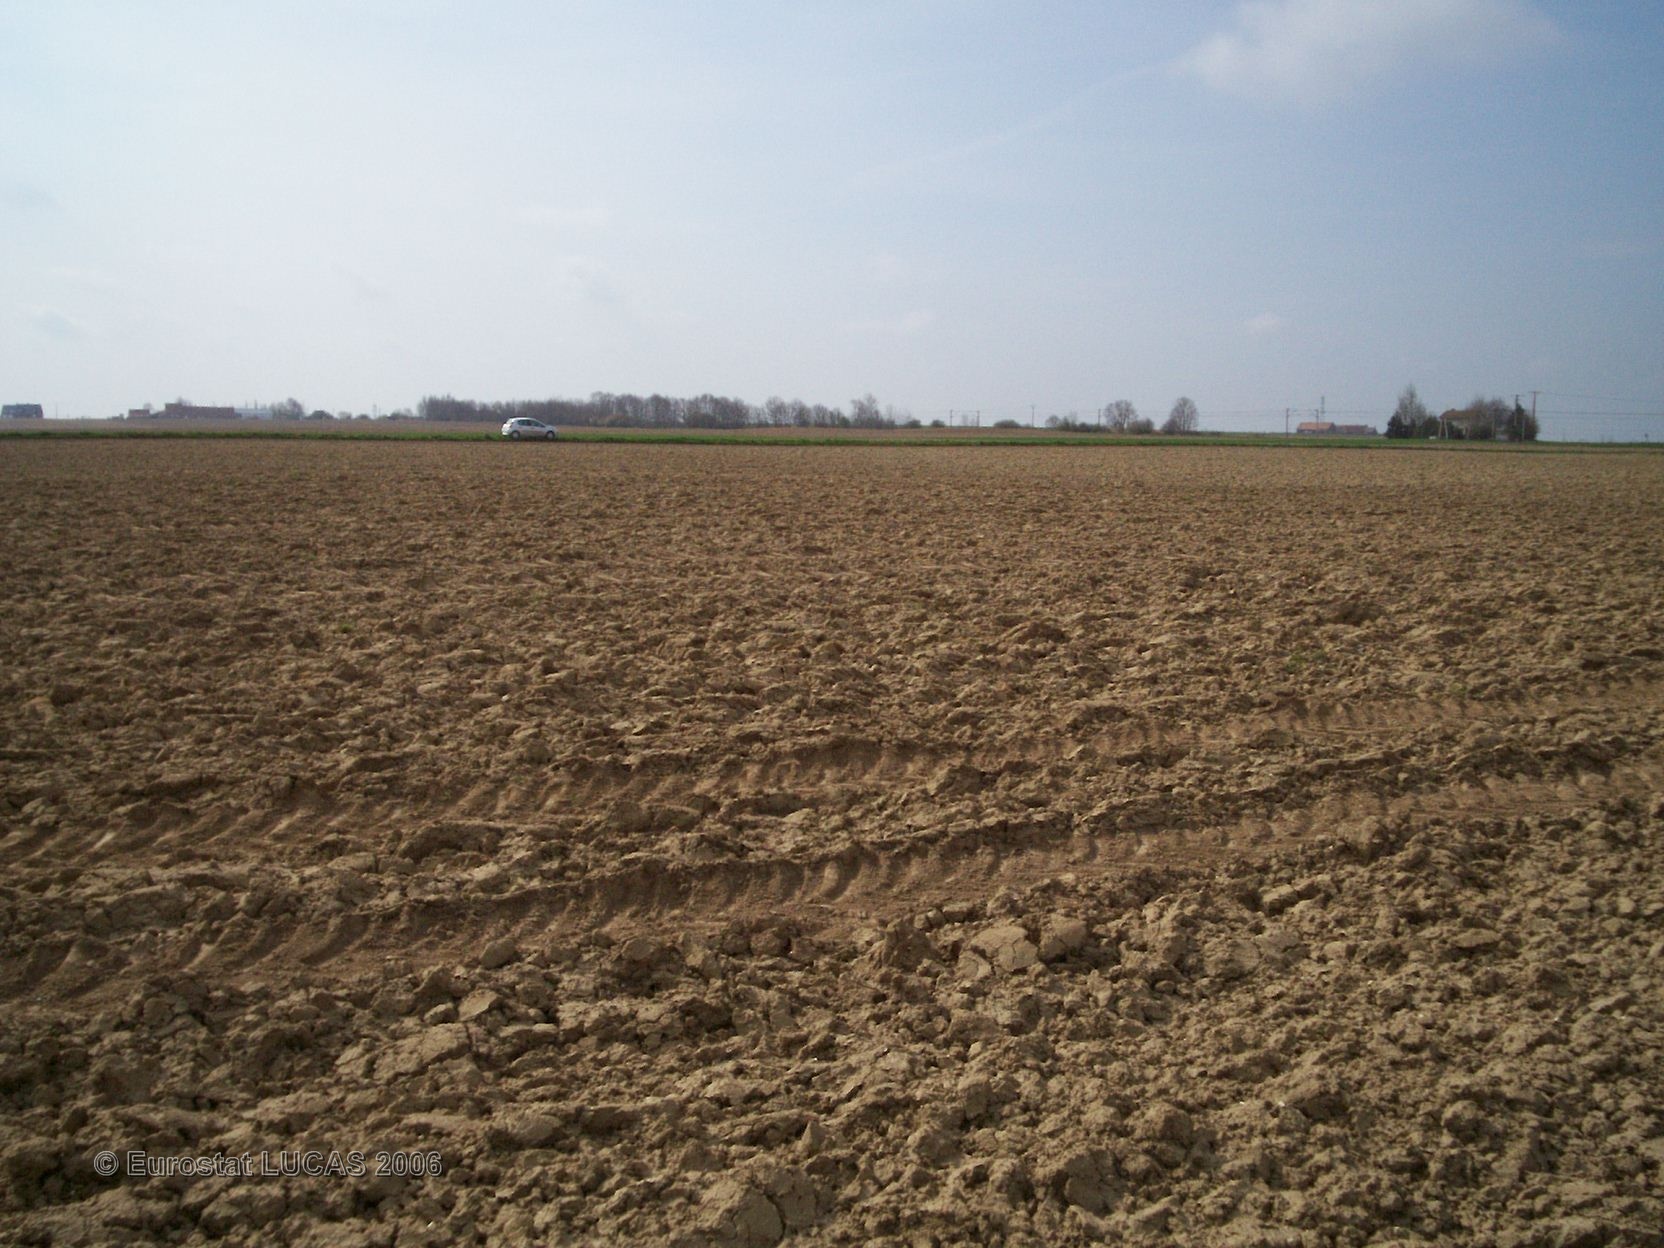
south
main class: Cropland
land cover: Potatoes
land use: Agriculture (excluding fallow land and kitchen gardens)
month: May
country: FR
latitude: 50.7669
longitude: 2.4867
